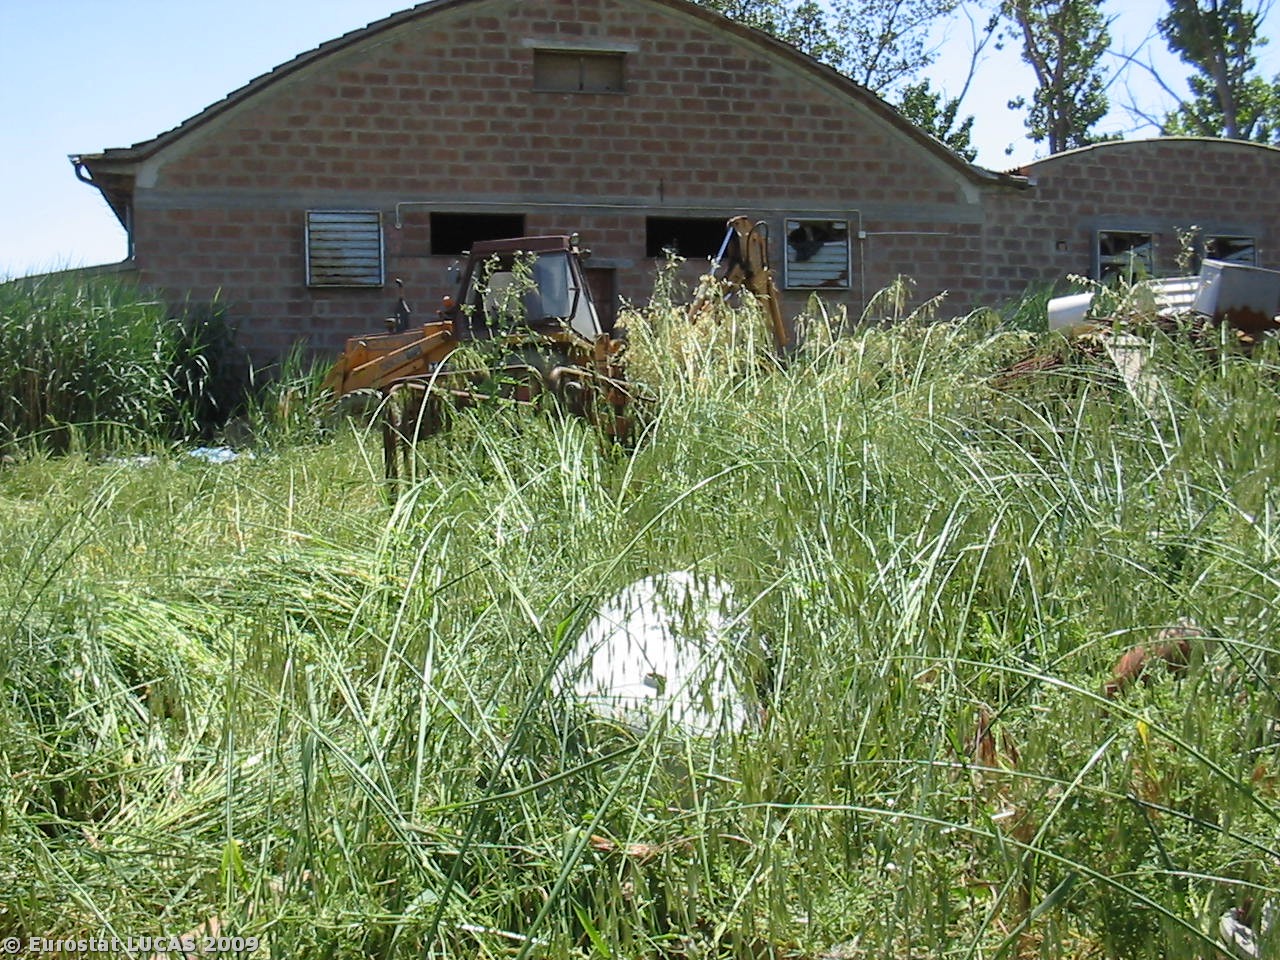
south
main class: Cropland
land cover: Common wheat
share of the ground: > 75 %
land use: Agriculture (excluding fallow land and kitchen gardens)
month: May
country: IT
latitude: 43.0859
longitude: 11.9963
